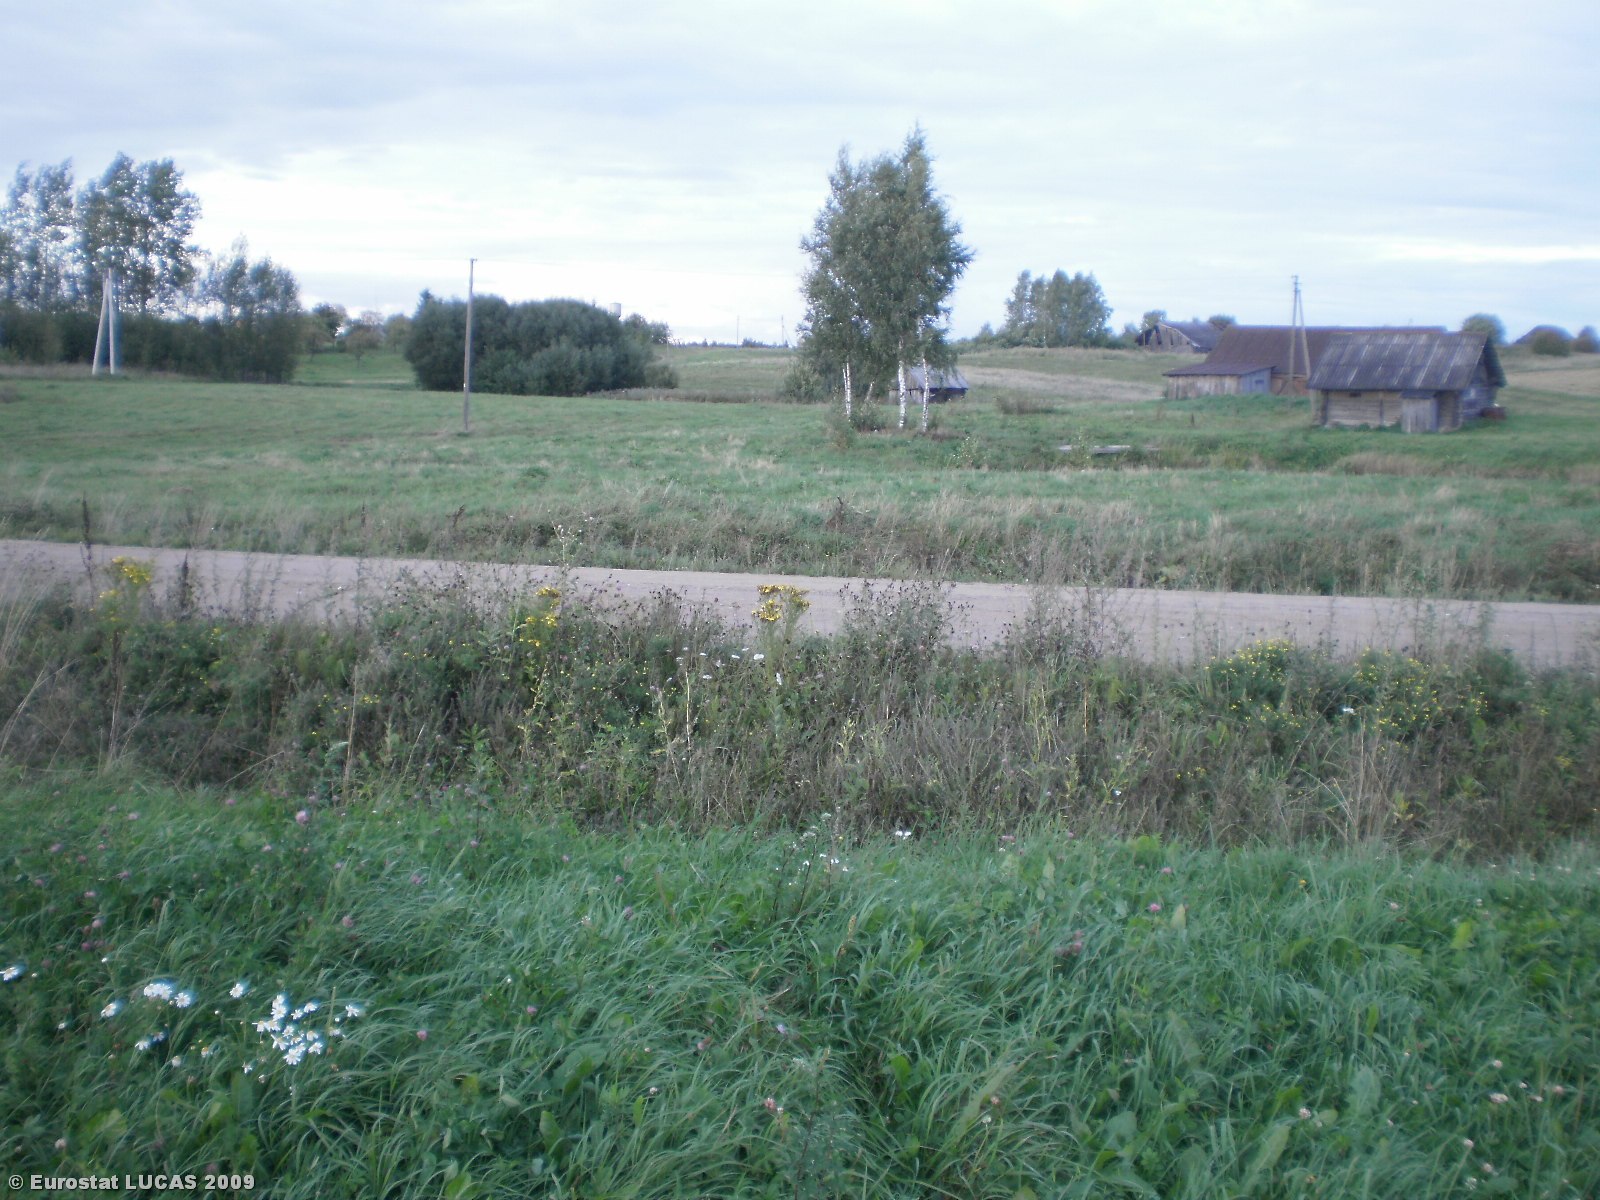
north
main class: Grassland
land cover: Grassland without tree/shrub cover
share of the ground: > 75 %
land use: Agriculture (excluding fallow land and kitchen gardens)
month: August
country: LT
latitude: 55.0872
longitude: 25.5272
